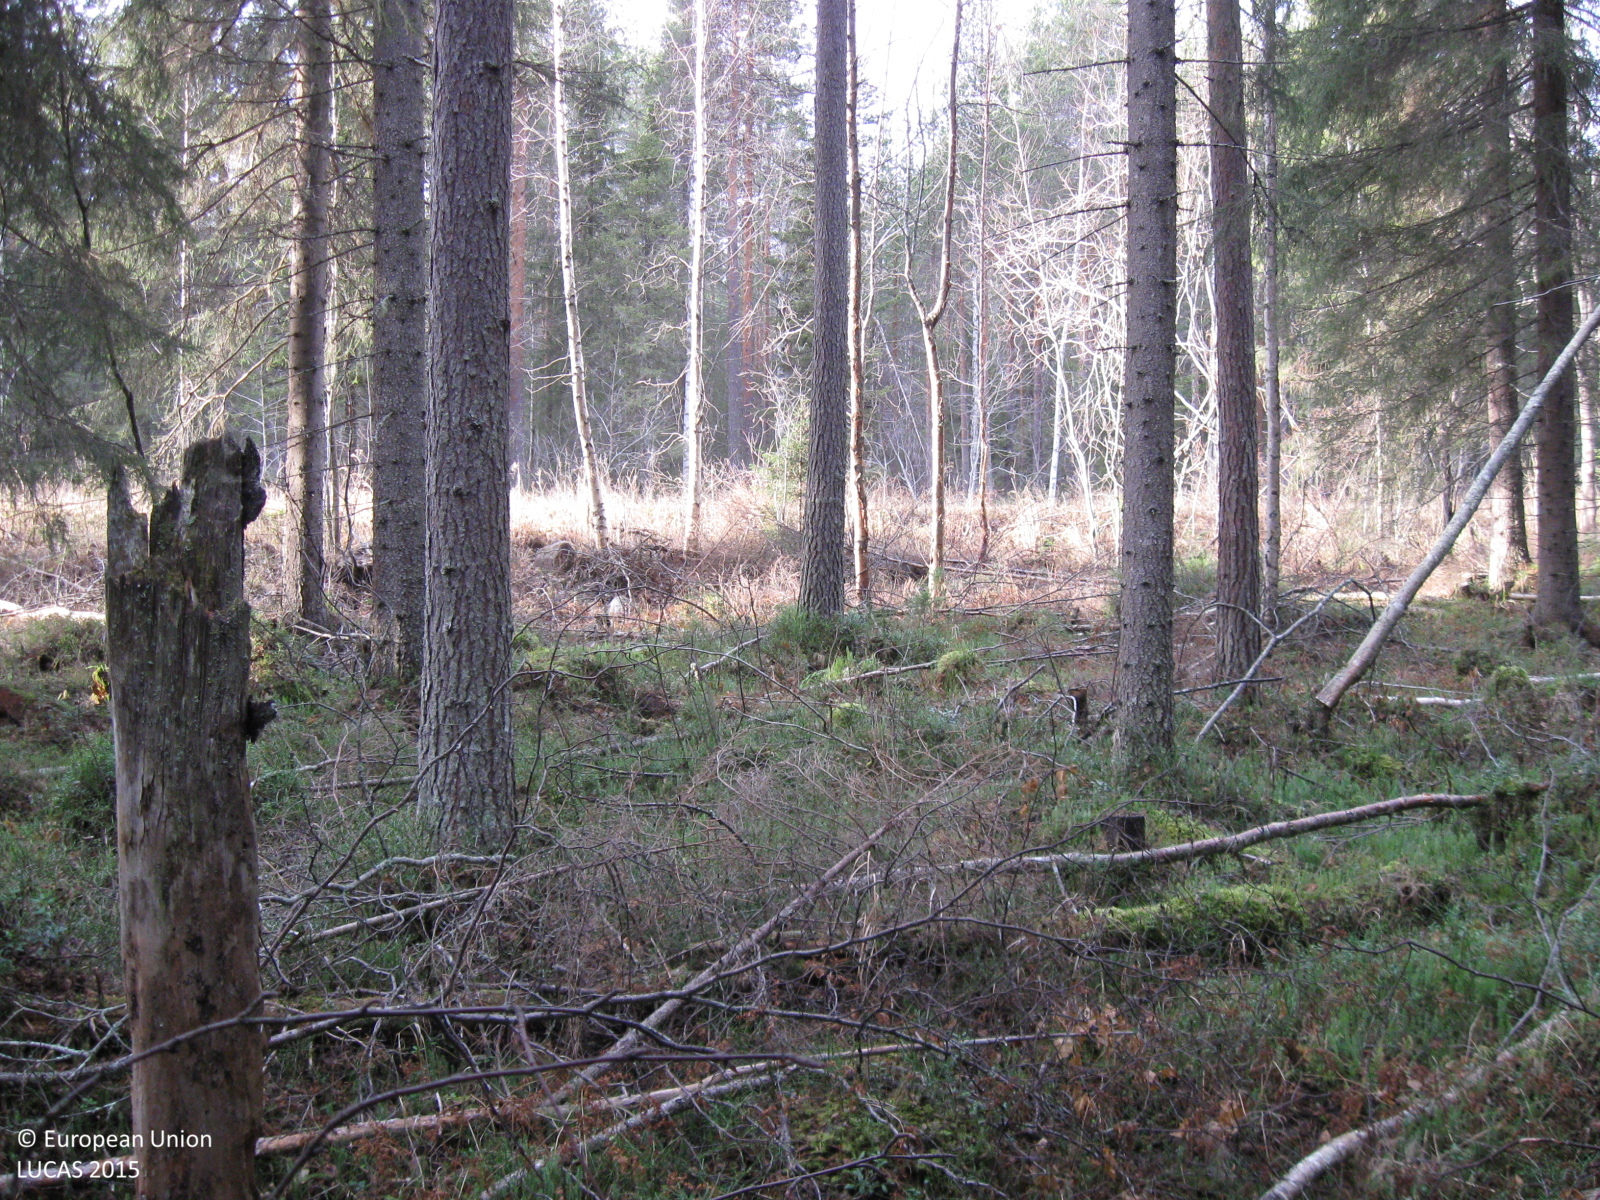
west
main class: Woodland
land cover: Spruce dominated coniferous woodland
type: boreal forest
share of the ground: > 75 %
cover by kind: coniferous forest trees 80 %, broadleaved forest trees 5 %, shrubs 5 %, herbaceous plants 5 %, lichens and mosses 5 %
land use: Forestry
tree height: > 5 m
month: November
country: SE
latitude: 66.0888
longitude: 20.5963
